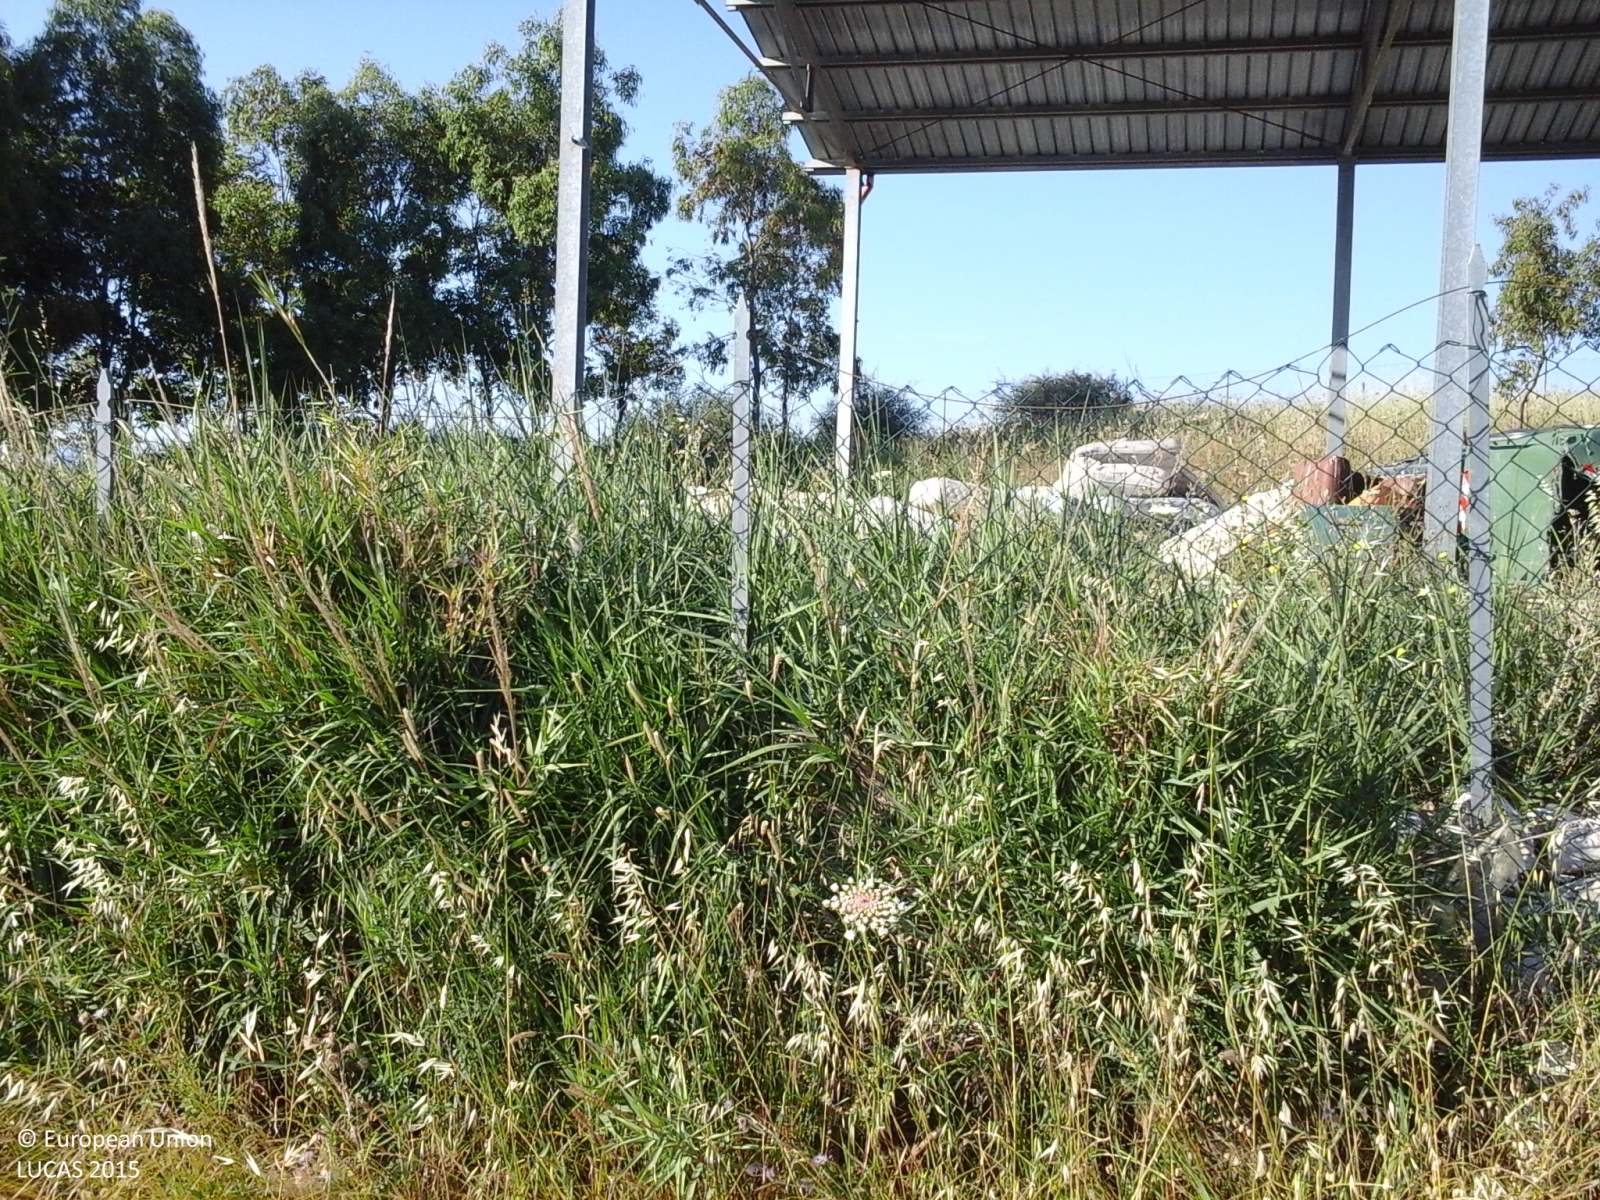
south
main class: Grassland
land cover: Grassland with sparse tree/shrub cover
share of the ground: > 75 %
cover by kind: herbaceous plants 85 %, shrubs 10 %, broadleaved forest trees 5 %
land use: Agriculture (excluding fallow land and kitchen gardens)
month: June
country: IT
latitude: 37.8282
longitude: 13.5080
